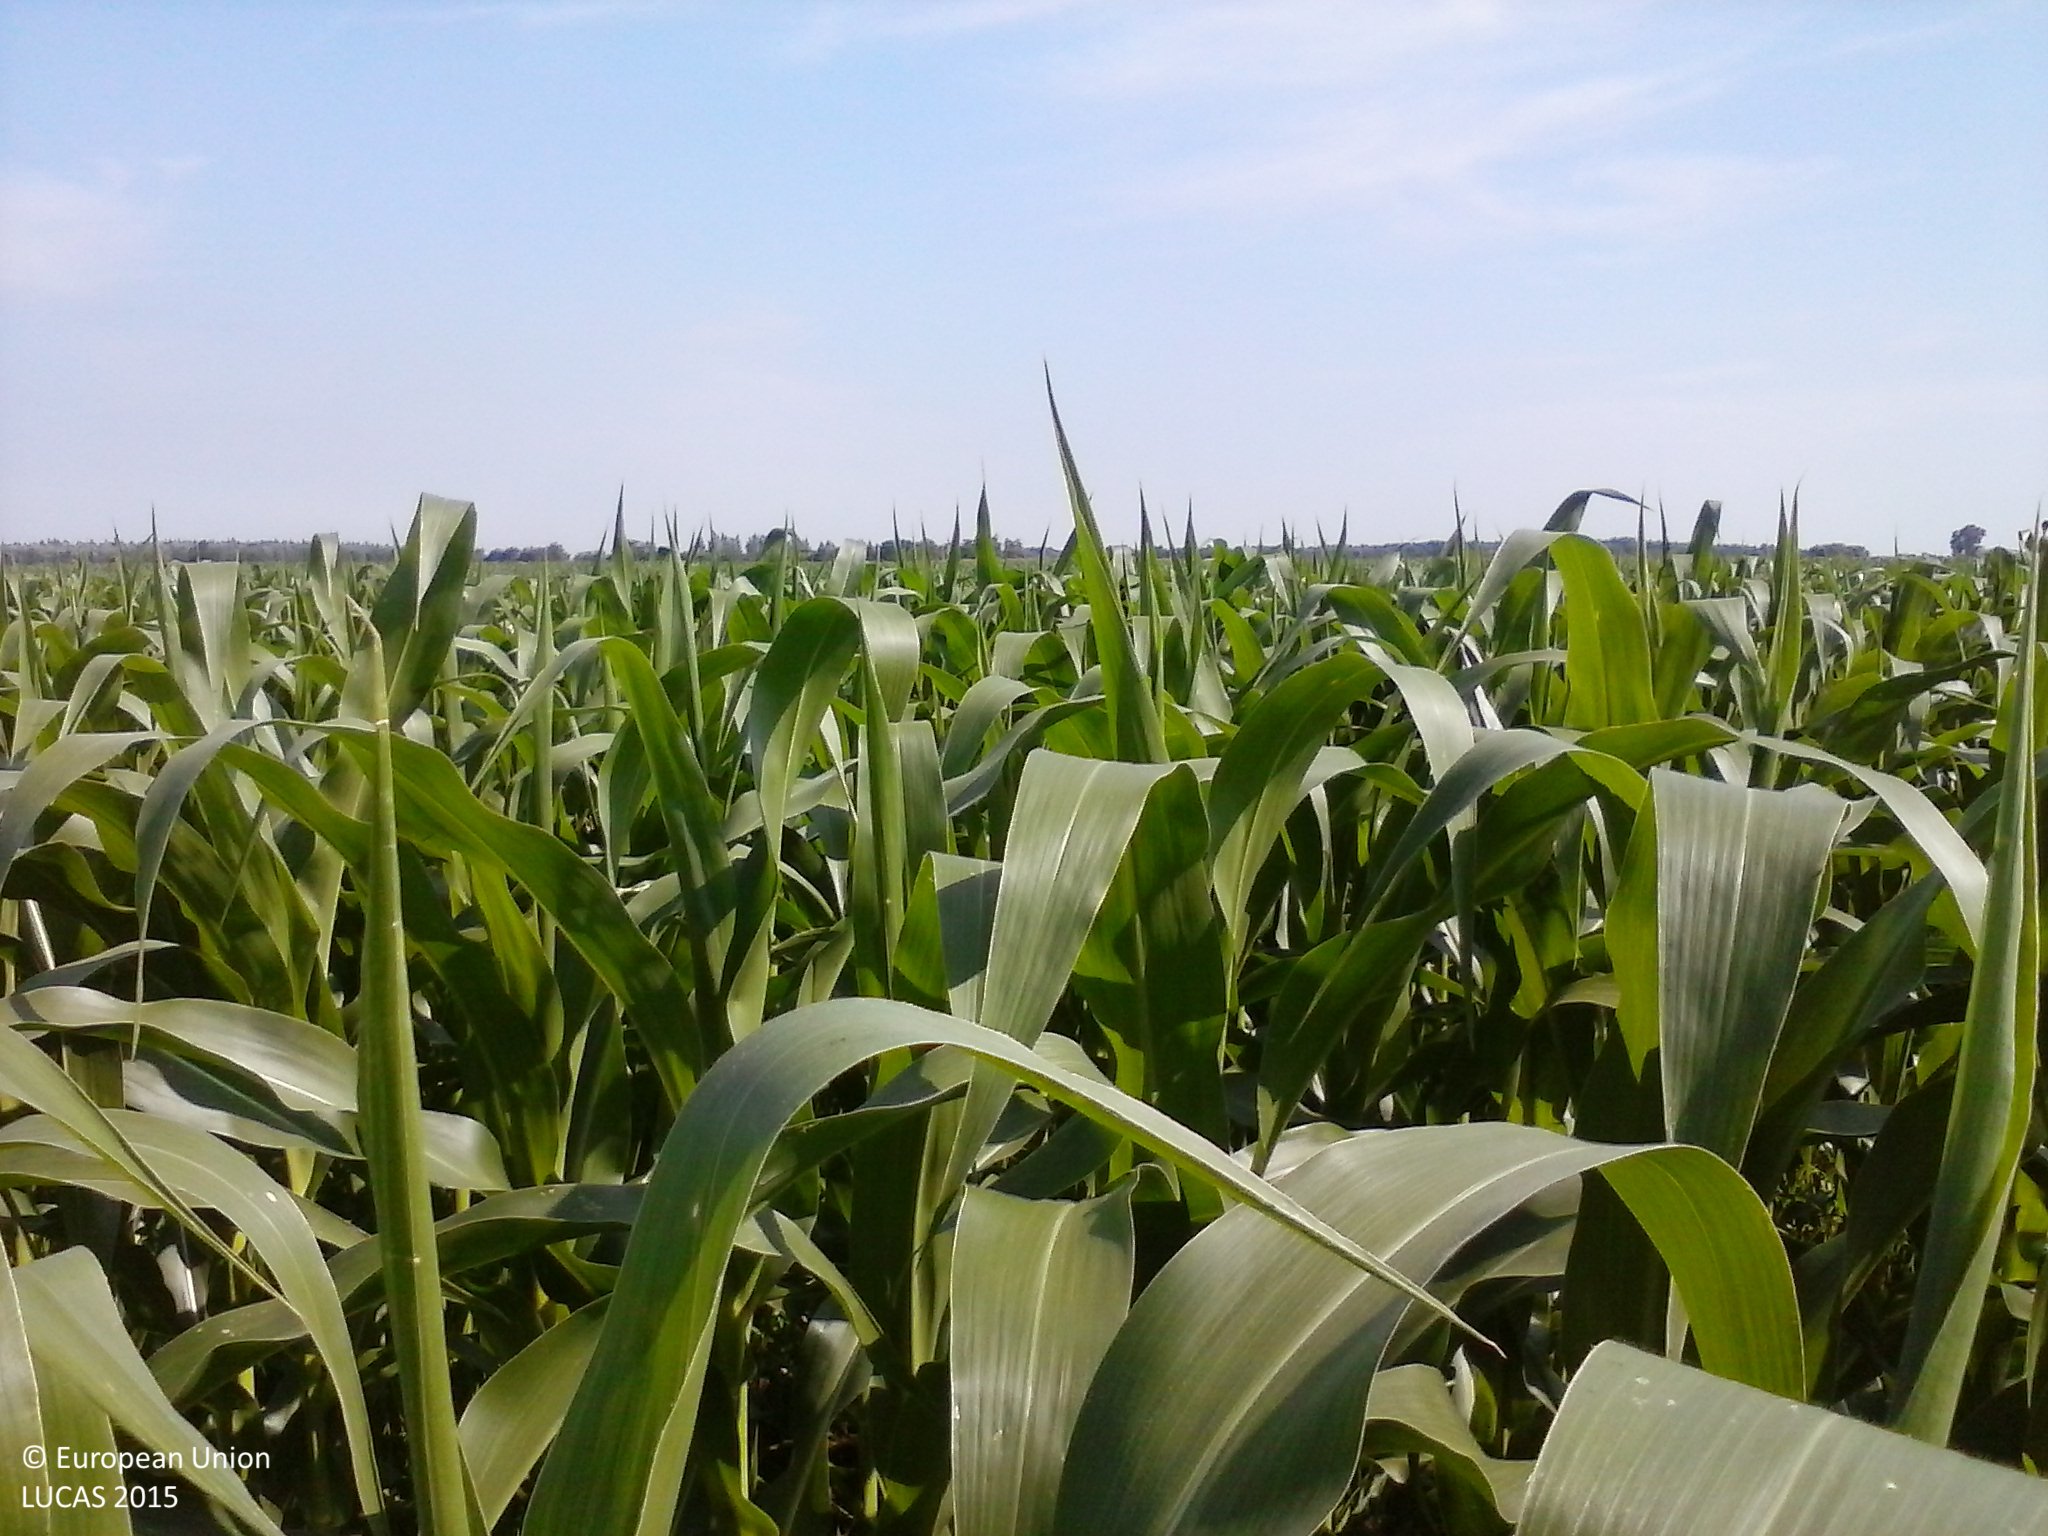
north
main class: Cropland
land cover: Maize
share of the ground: > 75 %
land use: Agriculture (excluding fallow land and kitchen gardens)
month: June
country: HU
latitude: 46.1624
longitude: 19.5087
